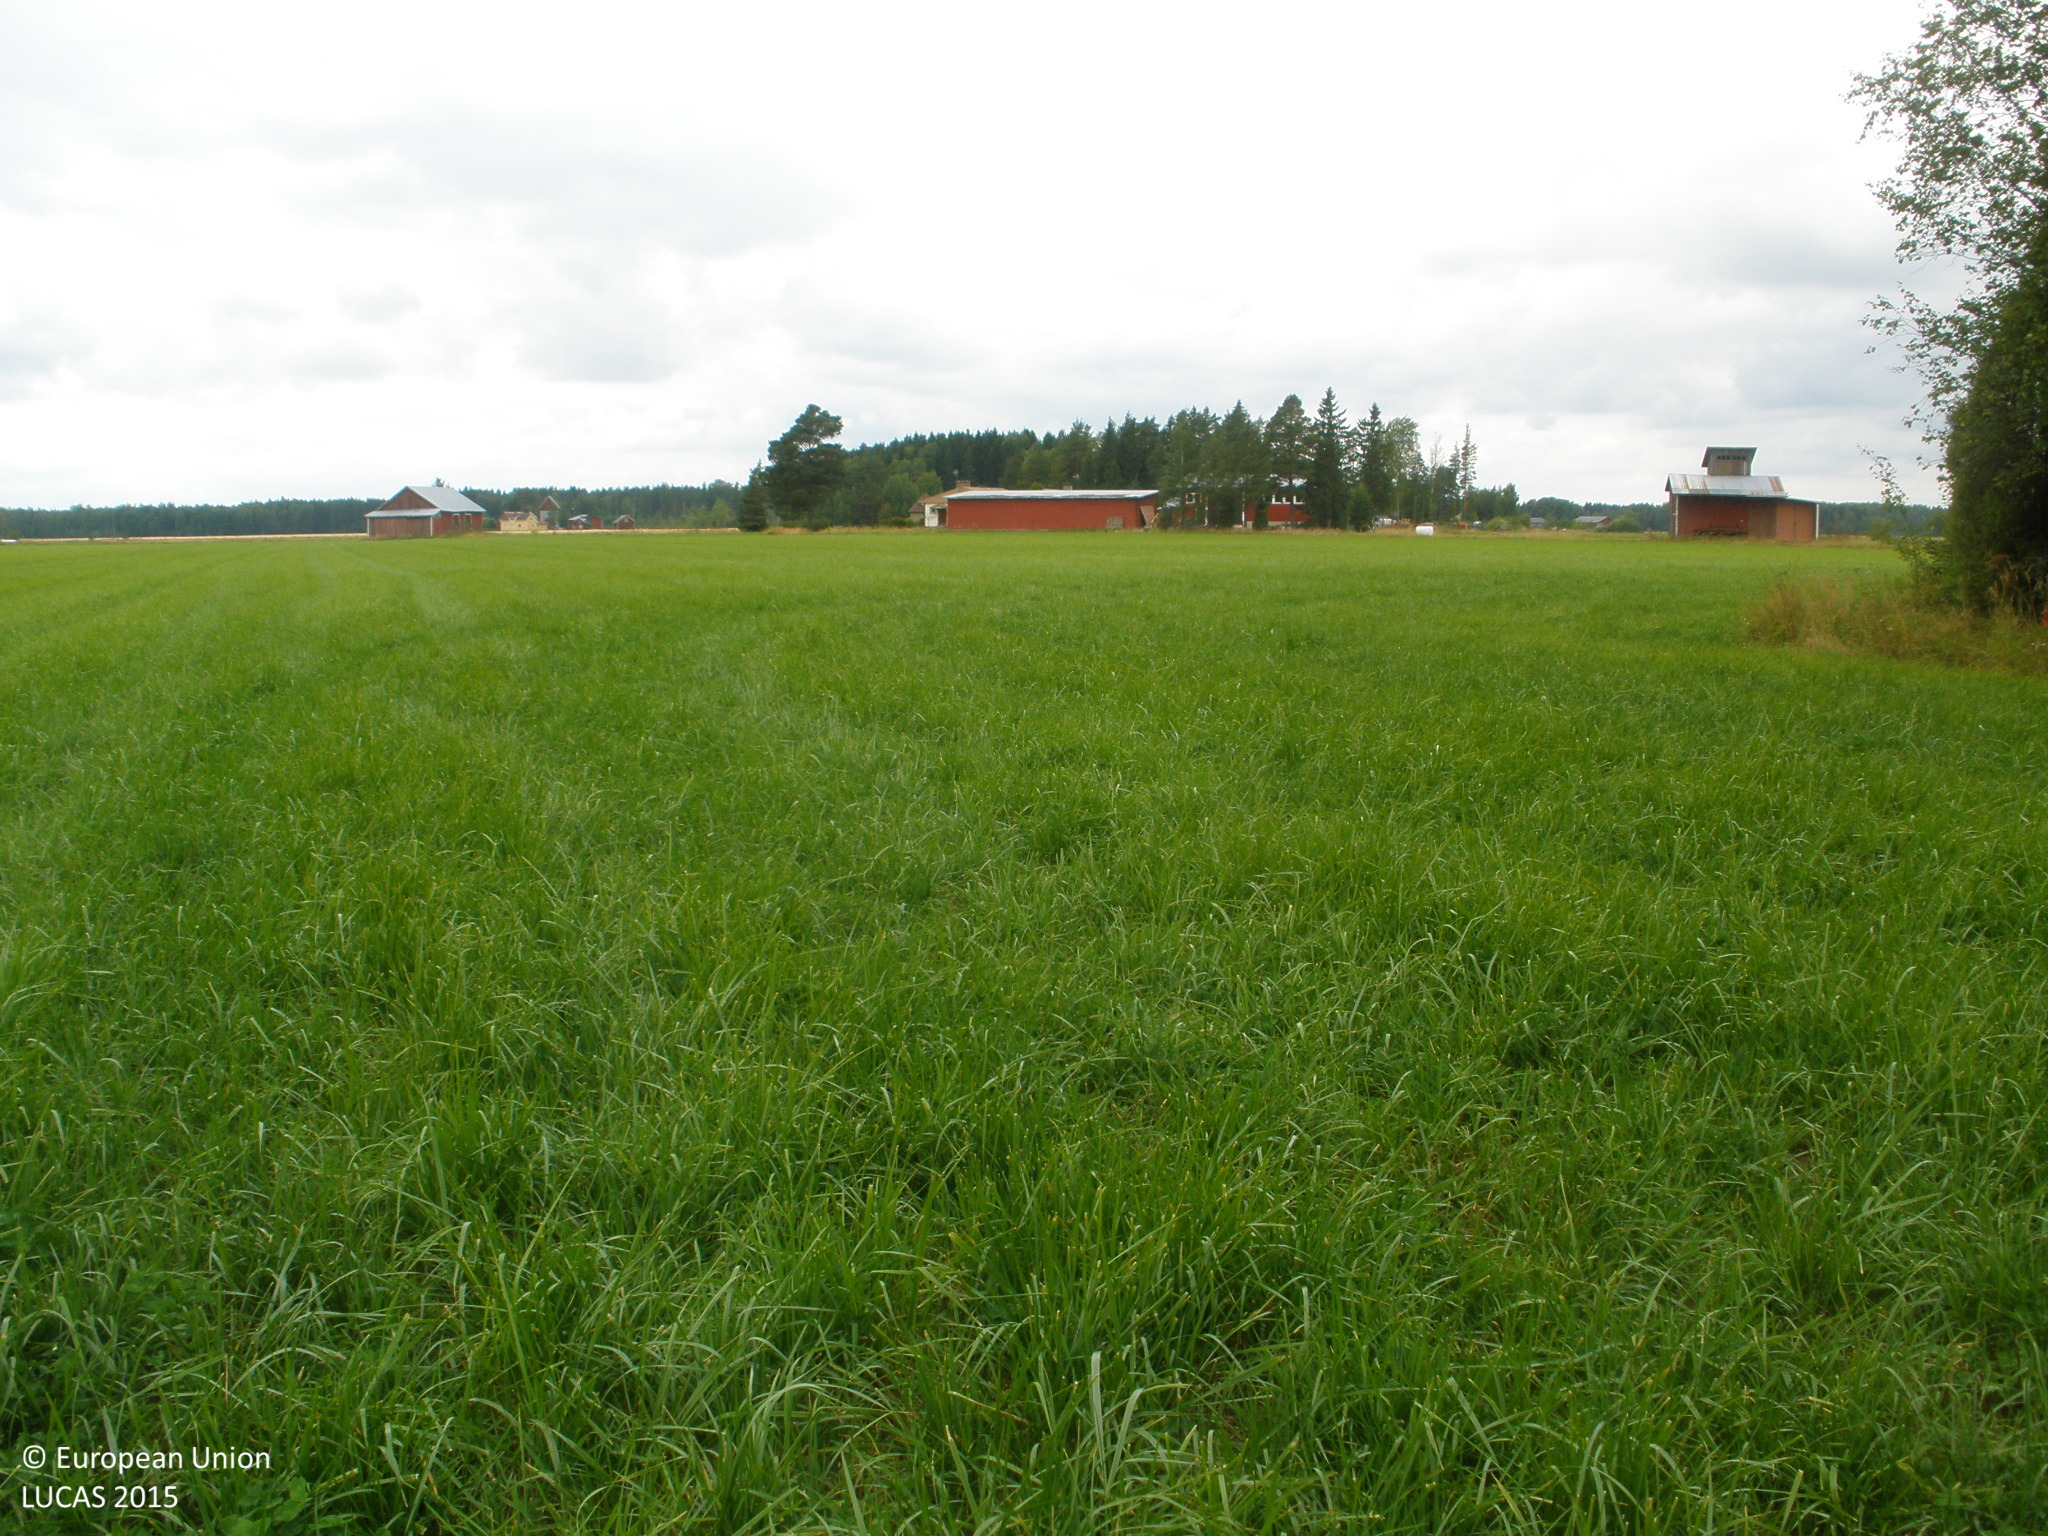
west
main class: Cropland
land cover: Temporary grasslands
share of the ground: > 75 %
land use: Agriculture (excluding fallow land and kitchen gardens)
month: August
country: FI
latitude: 60.5715
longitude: 23.4967
